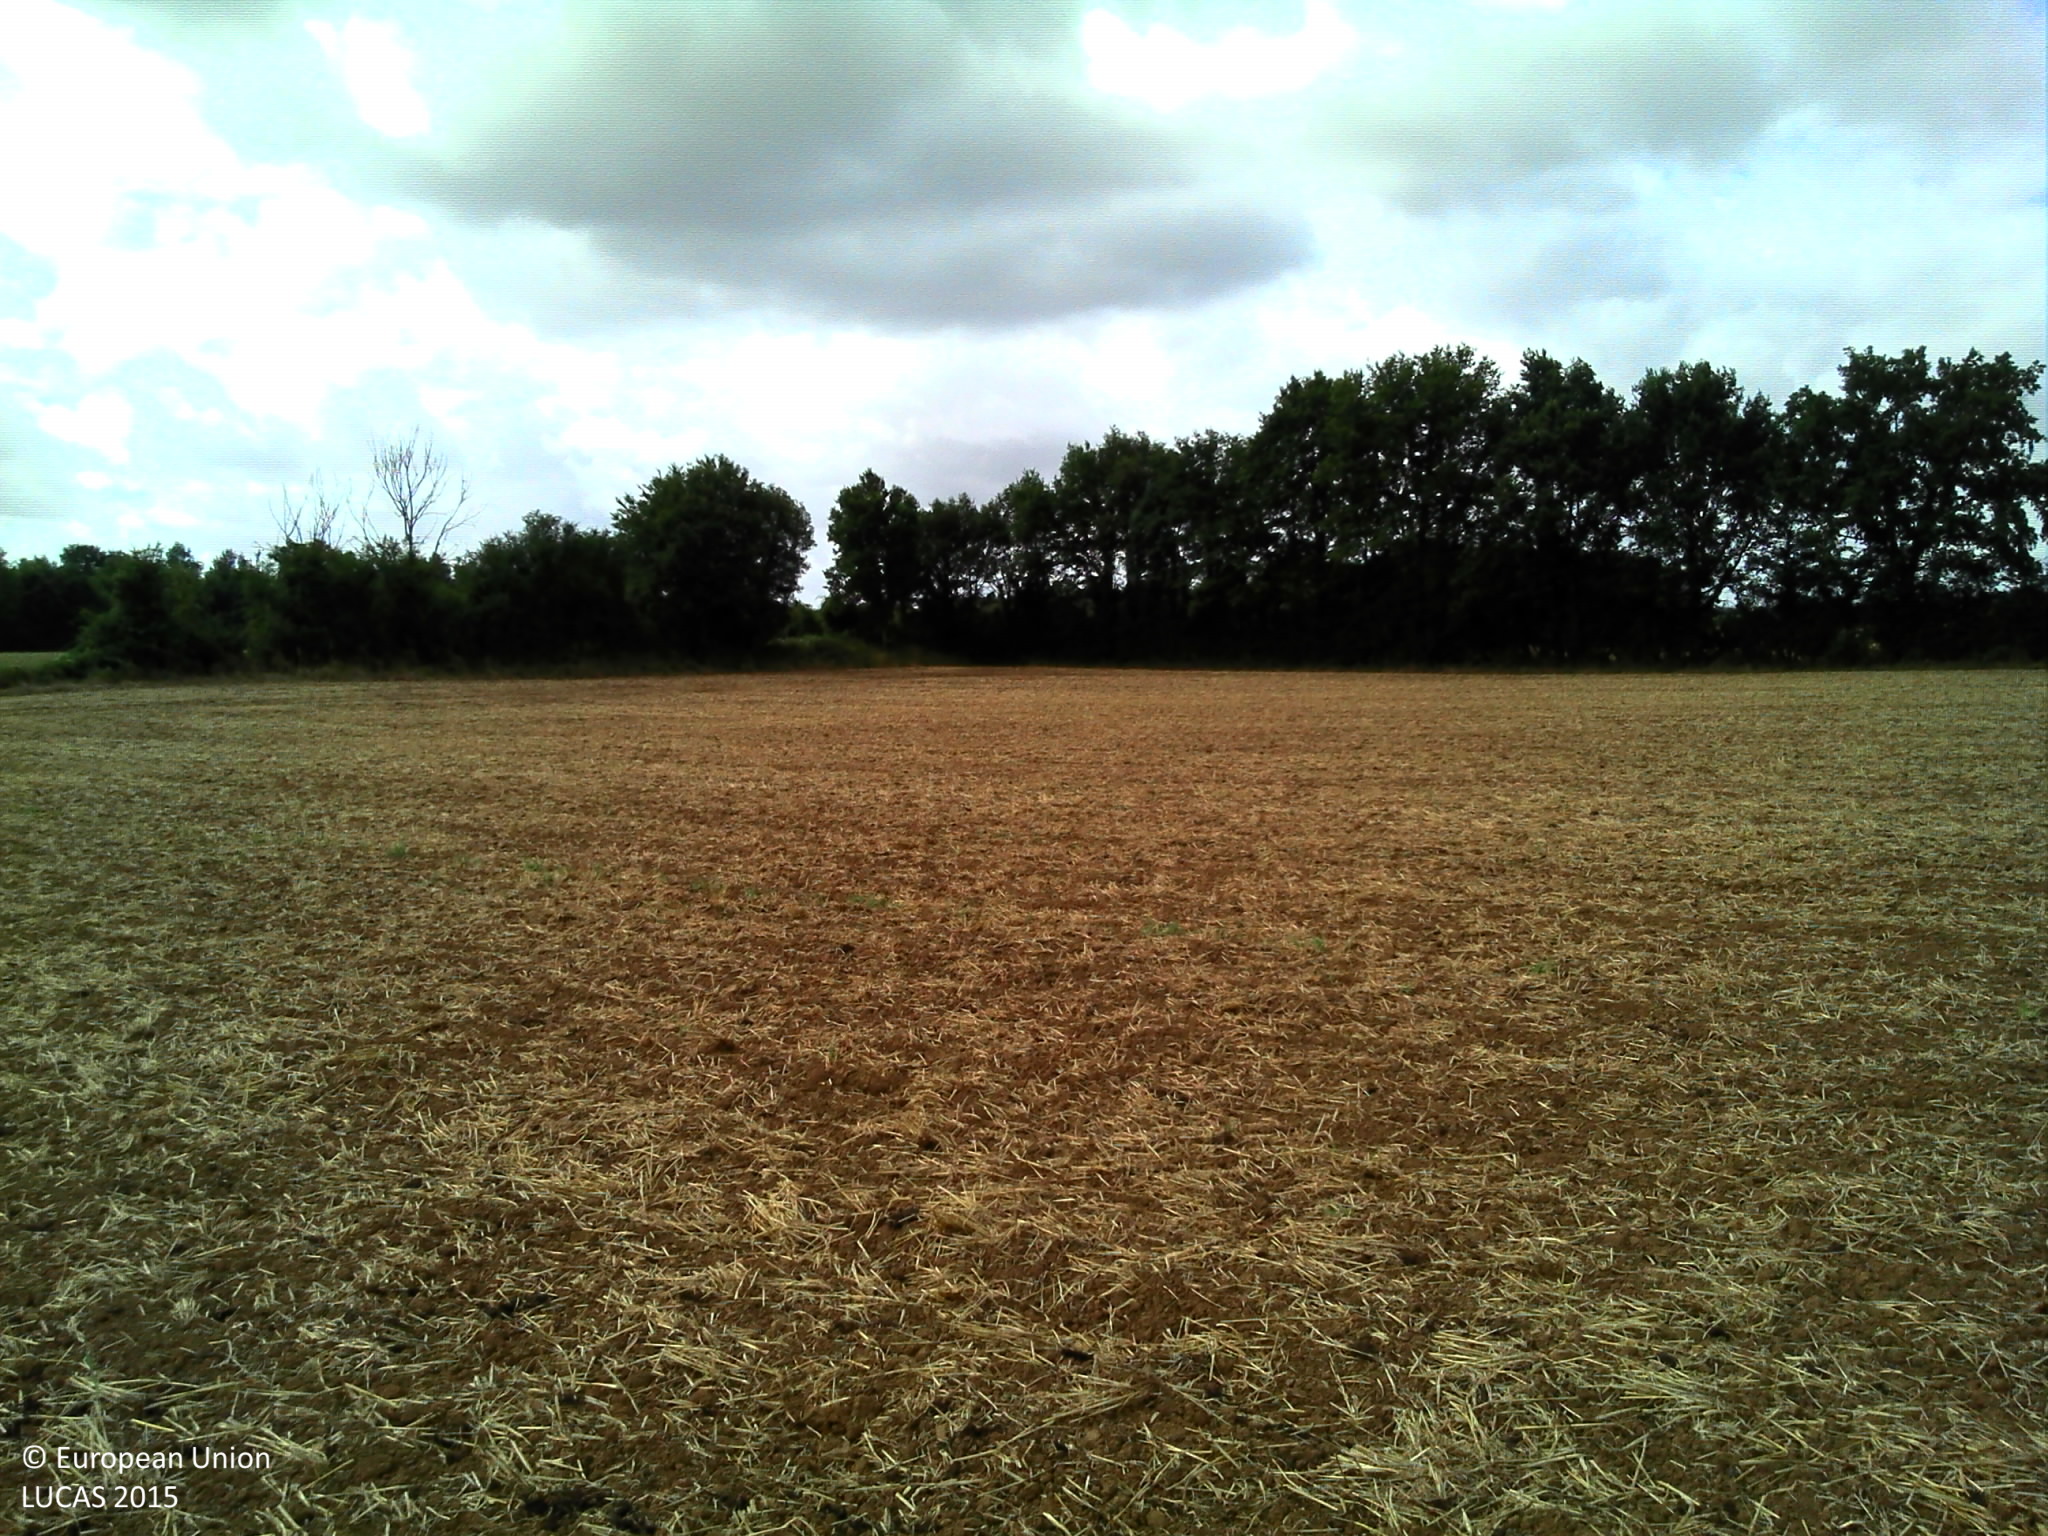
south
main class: Cropland
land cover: Barley
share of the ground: < 10 %
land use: Agriculture (excluding fallow land and kitchen gardens)
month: July
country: FR
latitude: 46.3912
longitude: 0.2144
